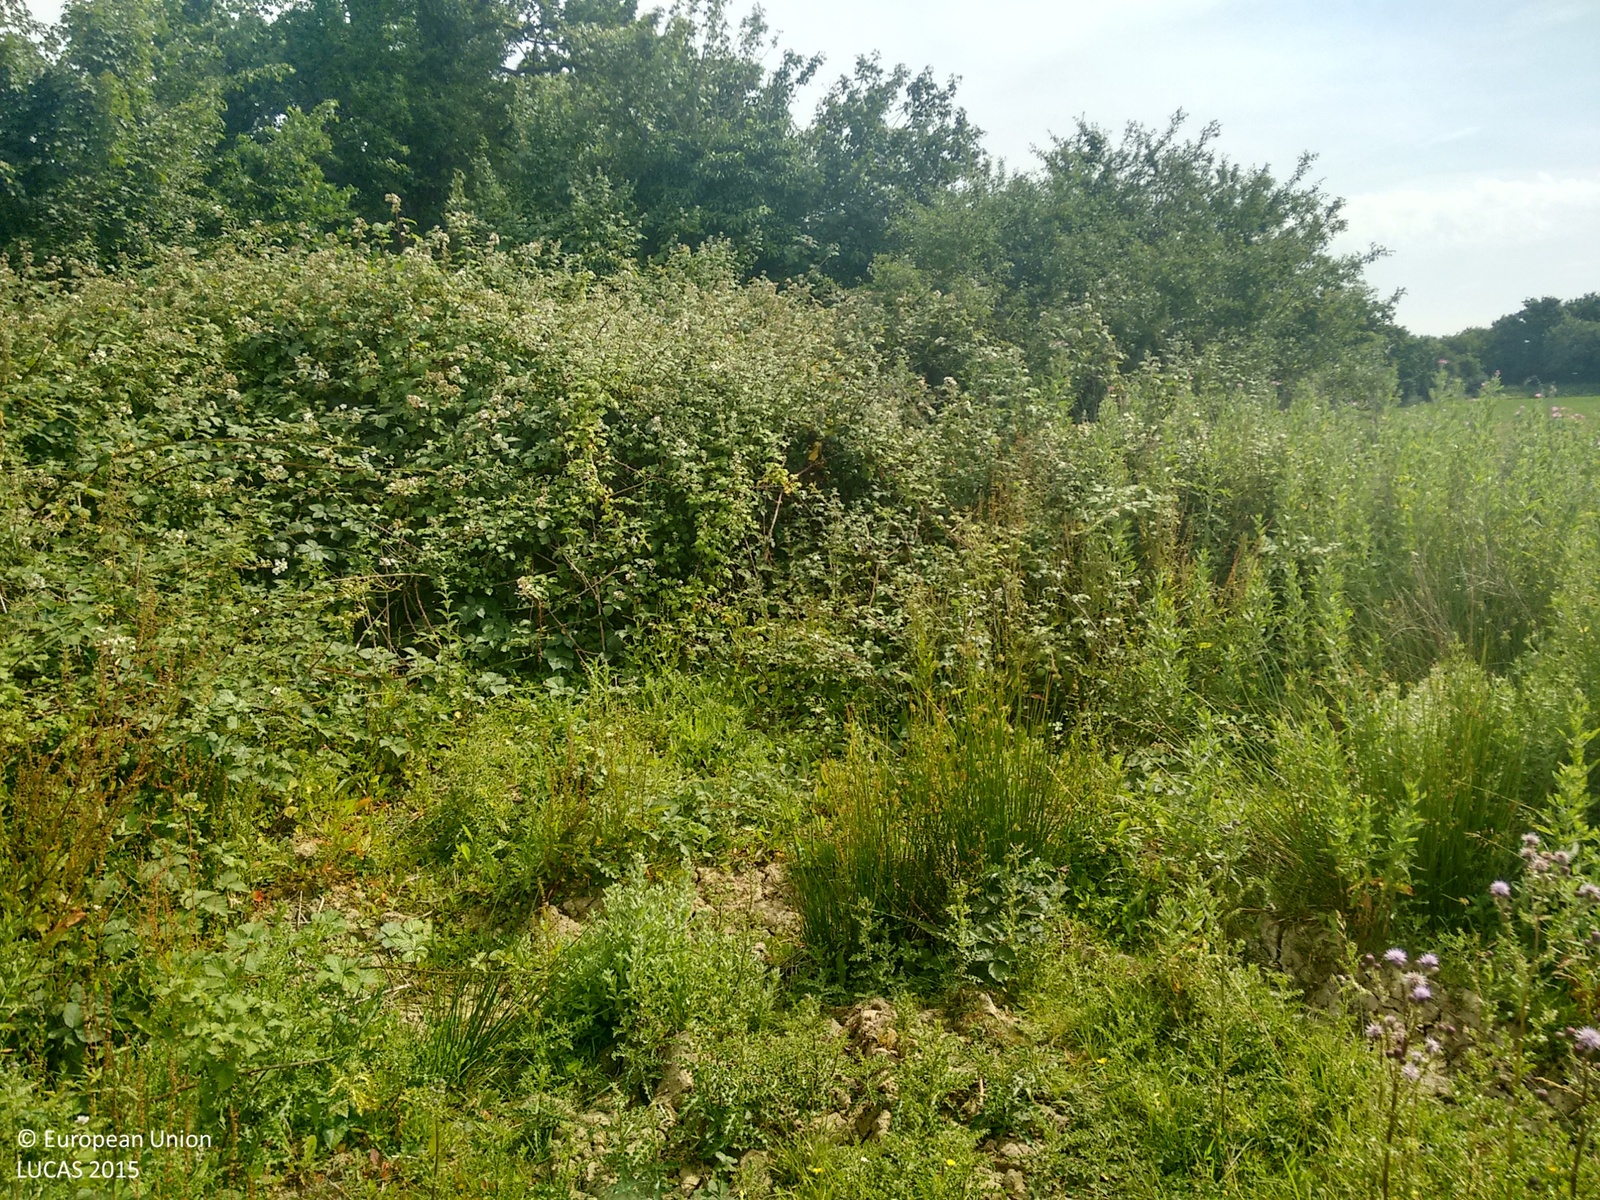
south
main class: Shrubland
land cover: Shrubland with sparse tree cover
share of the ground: > 75 %
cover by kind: shrubs 75 %, herbaceous plants 20 %, broadleaved forest trees 5 %
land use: Semi-natural and natural areas not in use
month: July
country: GB
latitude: 51.1930
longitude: -0.2090
